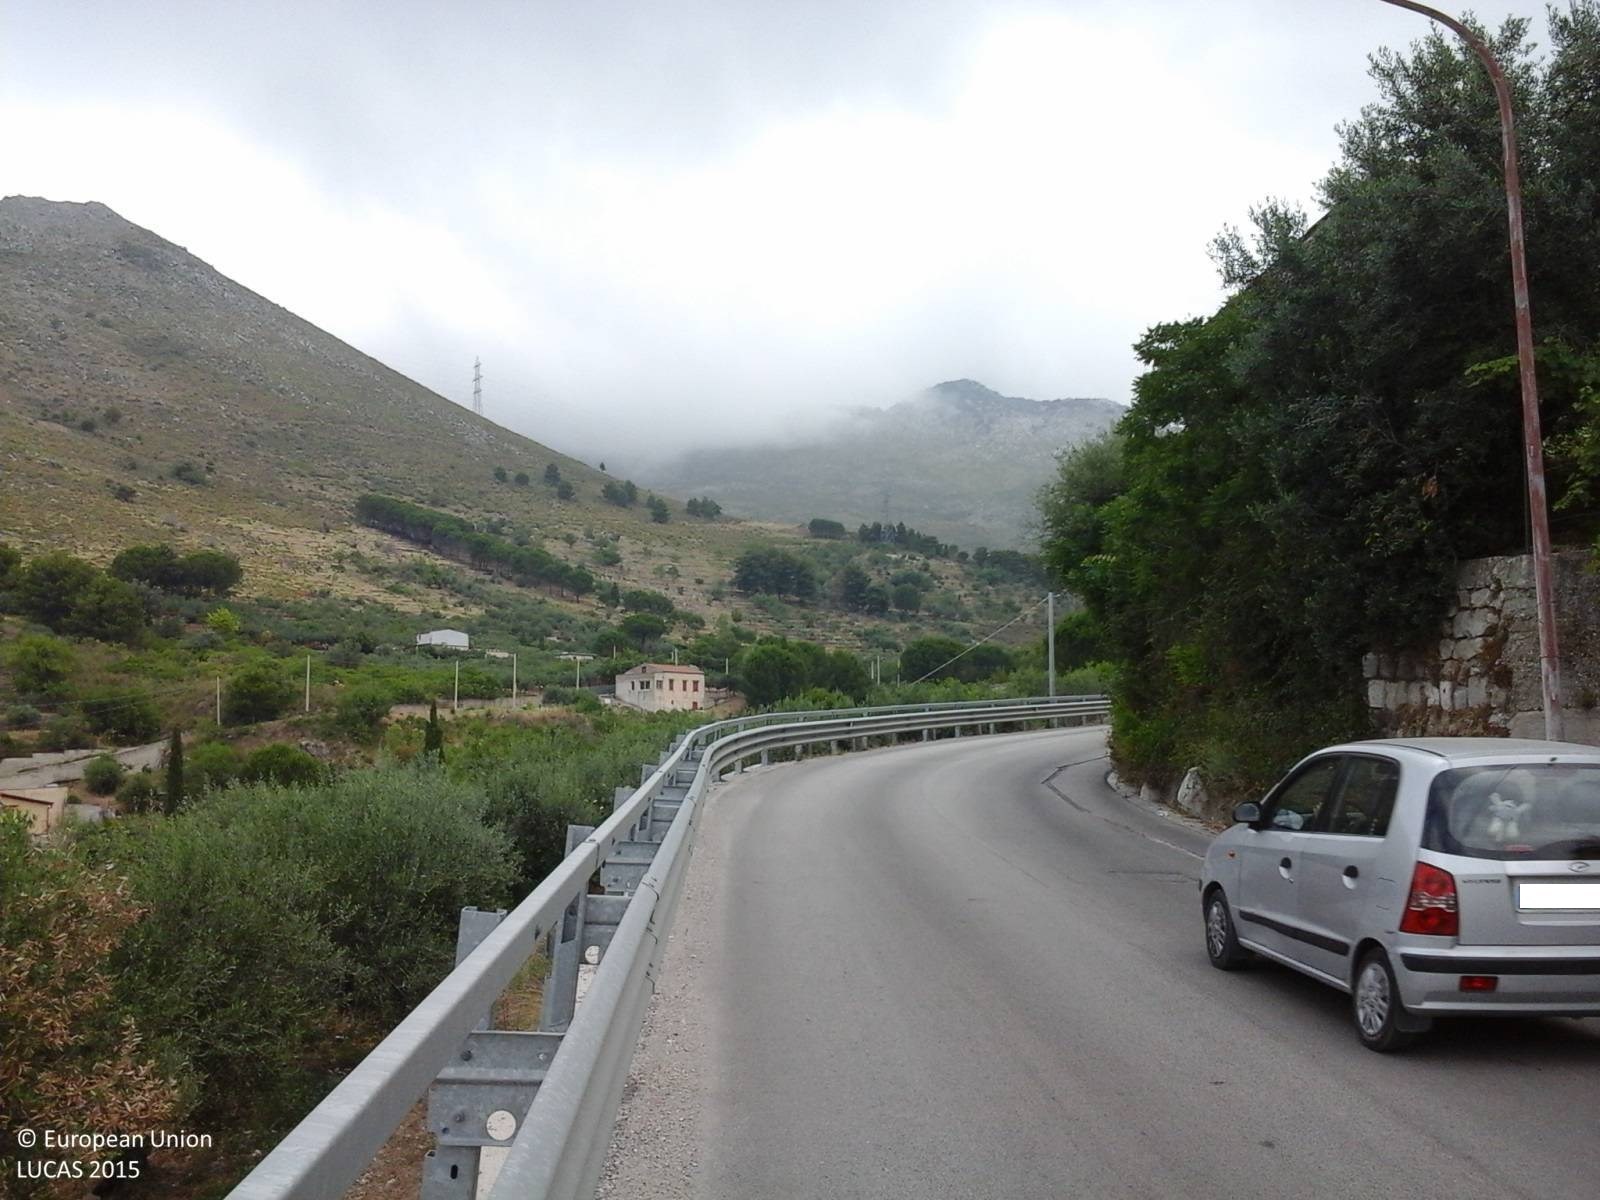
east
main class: Grassland
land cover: Grassland with sparse tree/shrub cover
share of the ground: > 75 %
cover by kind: herbaceous plants 85 %, shrubs 10 %, coniferous forest trees 5 %
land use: Semi-natural and natural areas not in use
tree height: < 5 m
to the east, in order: Grassland with sparse tree/shrub cover; Artificial constructions in urban areas; Olive groves; Electric lines; Olive groves; Electric lines; Broadleaved woodland; Paved roads, cycling and walking lanes
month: July
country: IT
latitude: 38.0939
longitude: 13.1817
